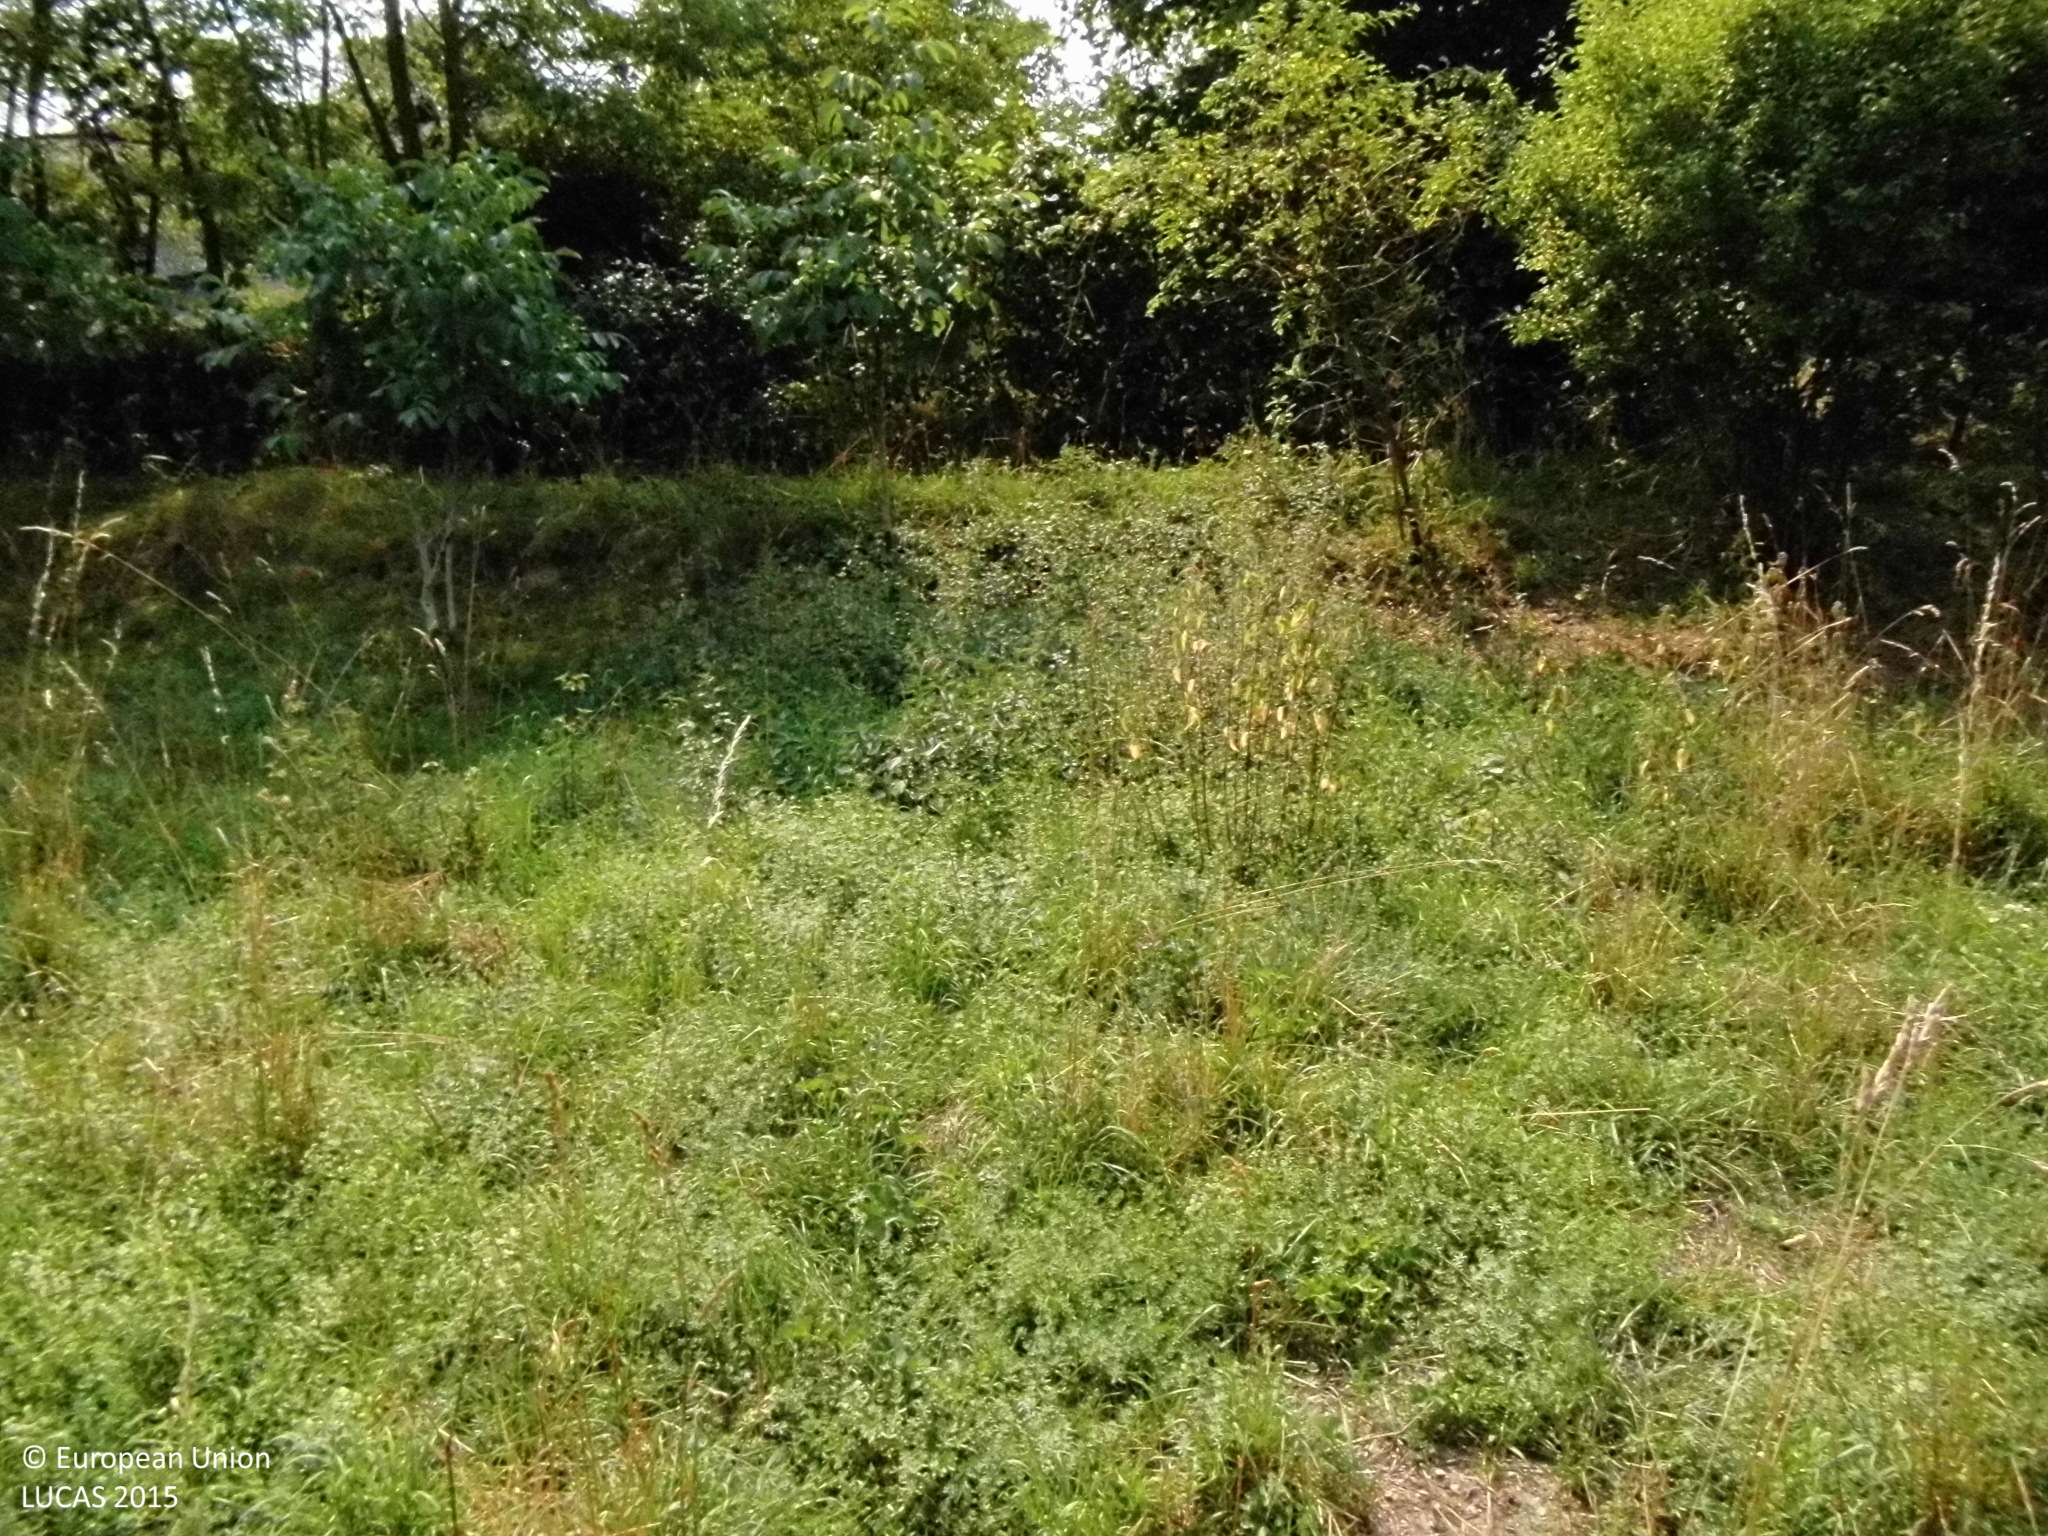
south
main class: Grassland
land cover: Grassland without tree/shrub cover
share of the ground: > 75 %
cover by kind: herbaceous plants 90 %, shrubs 5 %, unconsolidated bare surface 5 %
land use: Agriculture (excluding fallow land and kitchen gardens)
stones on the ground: 10 - 25 %
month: August
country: DE
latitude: 50.6972
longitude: 8.5988
